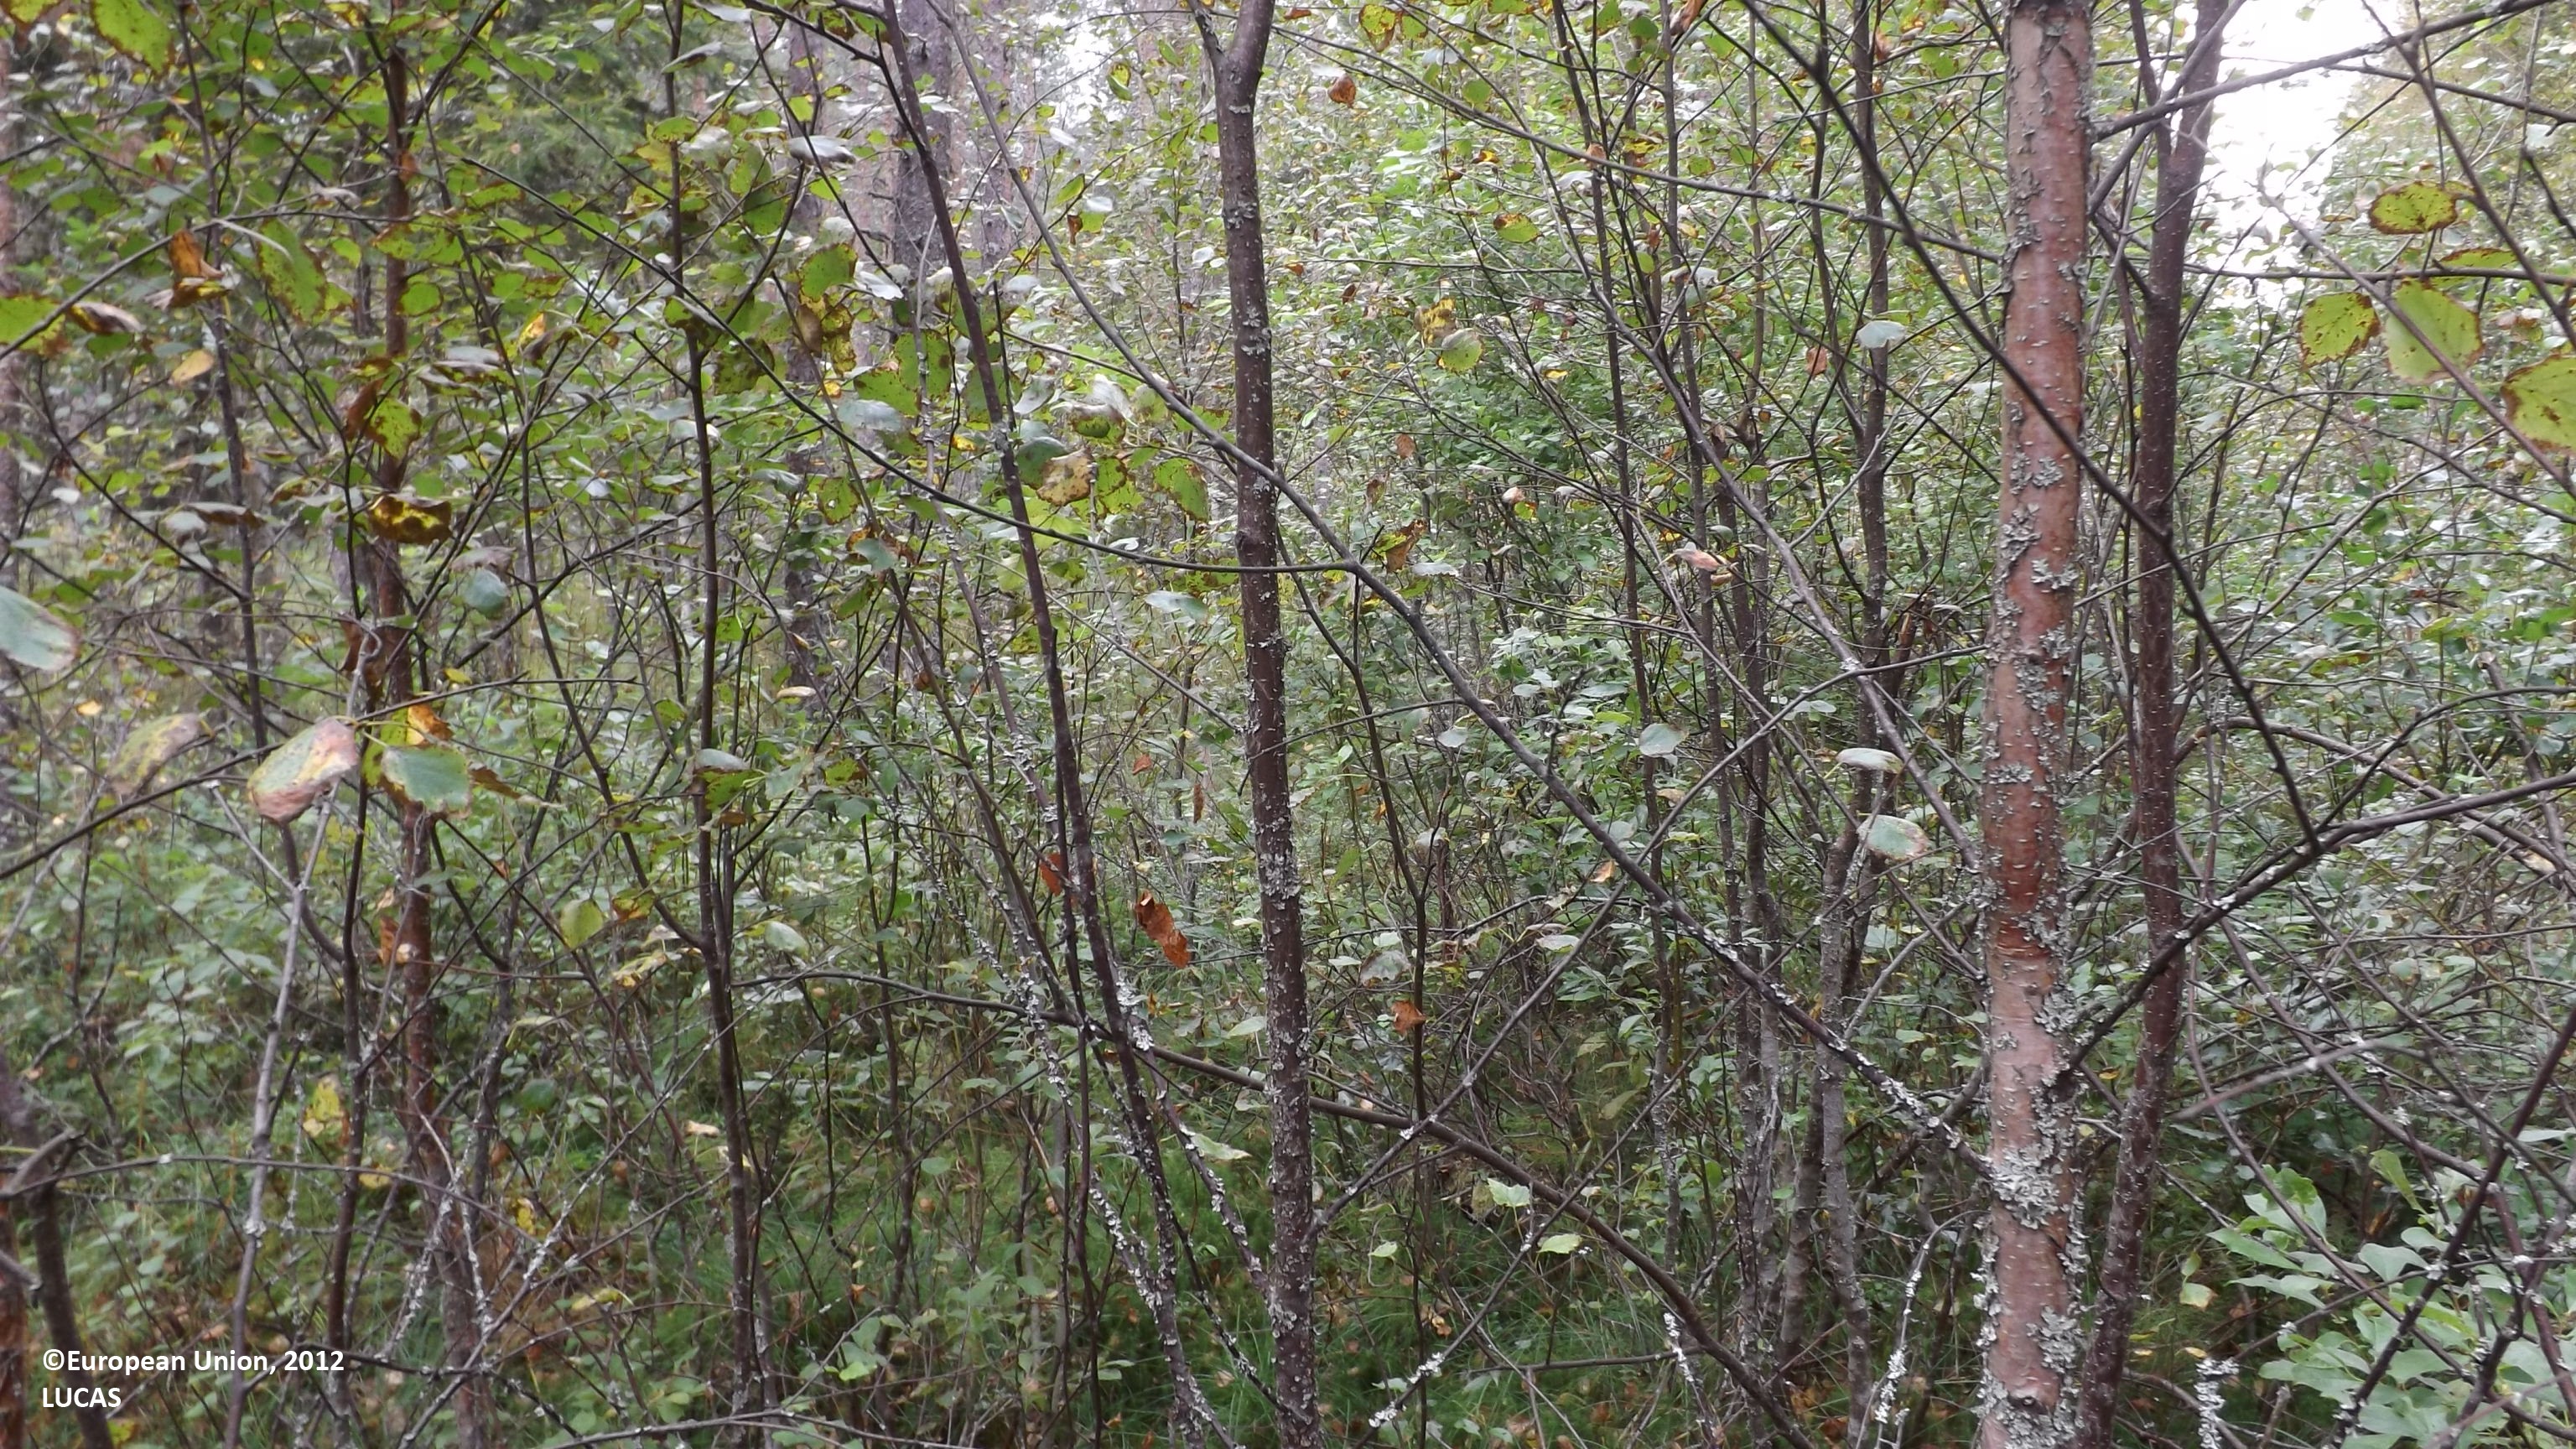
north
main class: Woodland
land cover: Other mixed woodland
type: boreal forest
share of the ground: 50 - 75 %
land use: Forestry
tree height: < 5 m
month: August
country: FI
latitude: 63.8367
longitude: 24.1153
